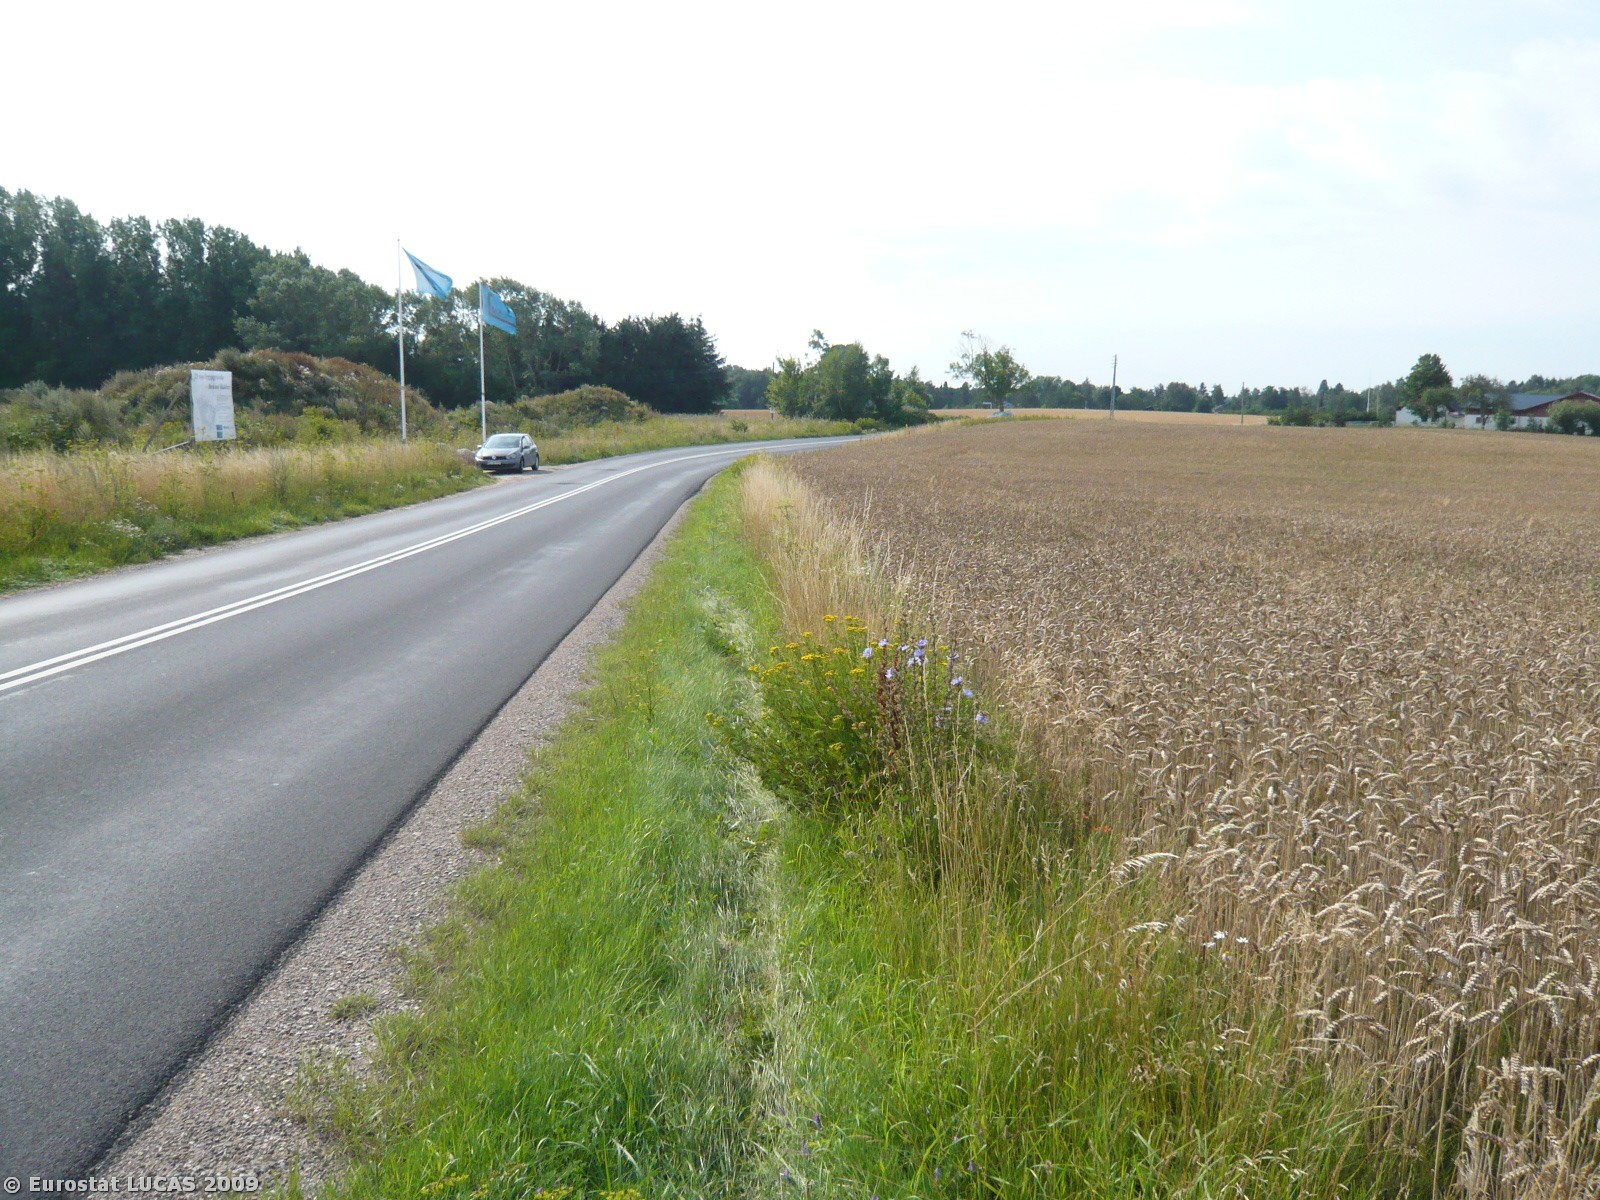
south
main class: Cropland
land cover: Common wheat
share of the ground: > 75 %
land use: Agriculture (excluding fallow land and kitchen gardens)
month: August
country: DK
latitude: 56.0072
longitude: 12.1951
